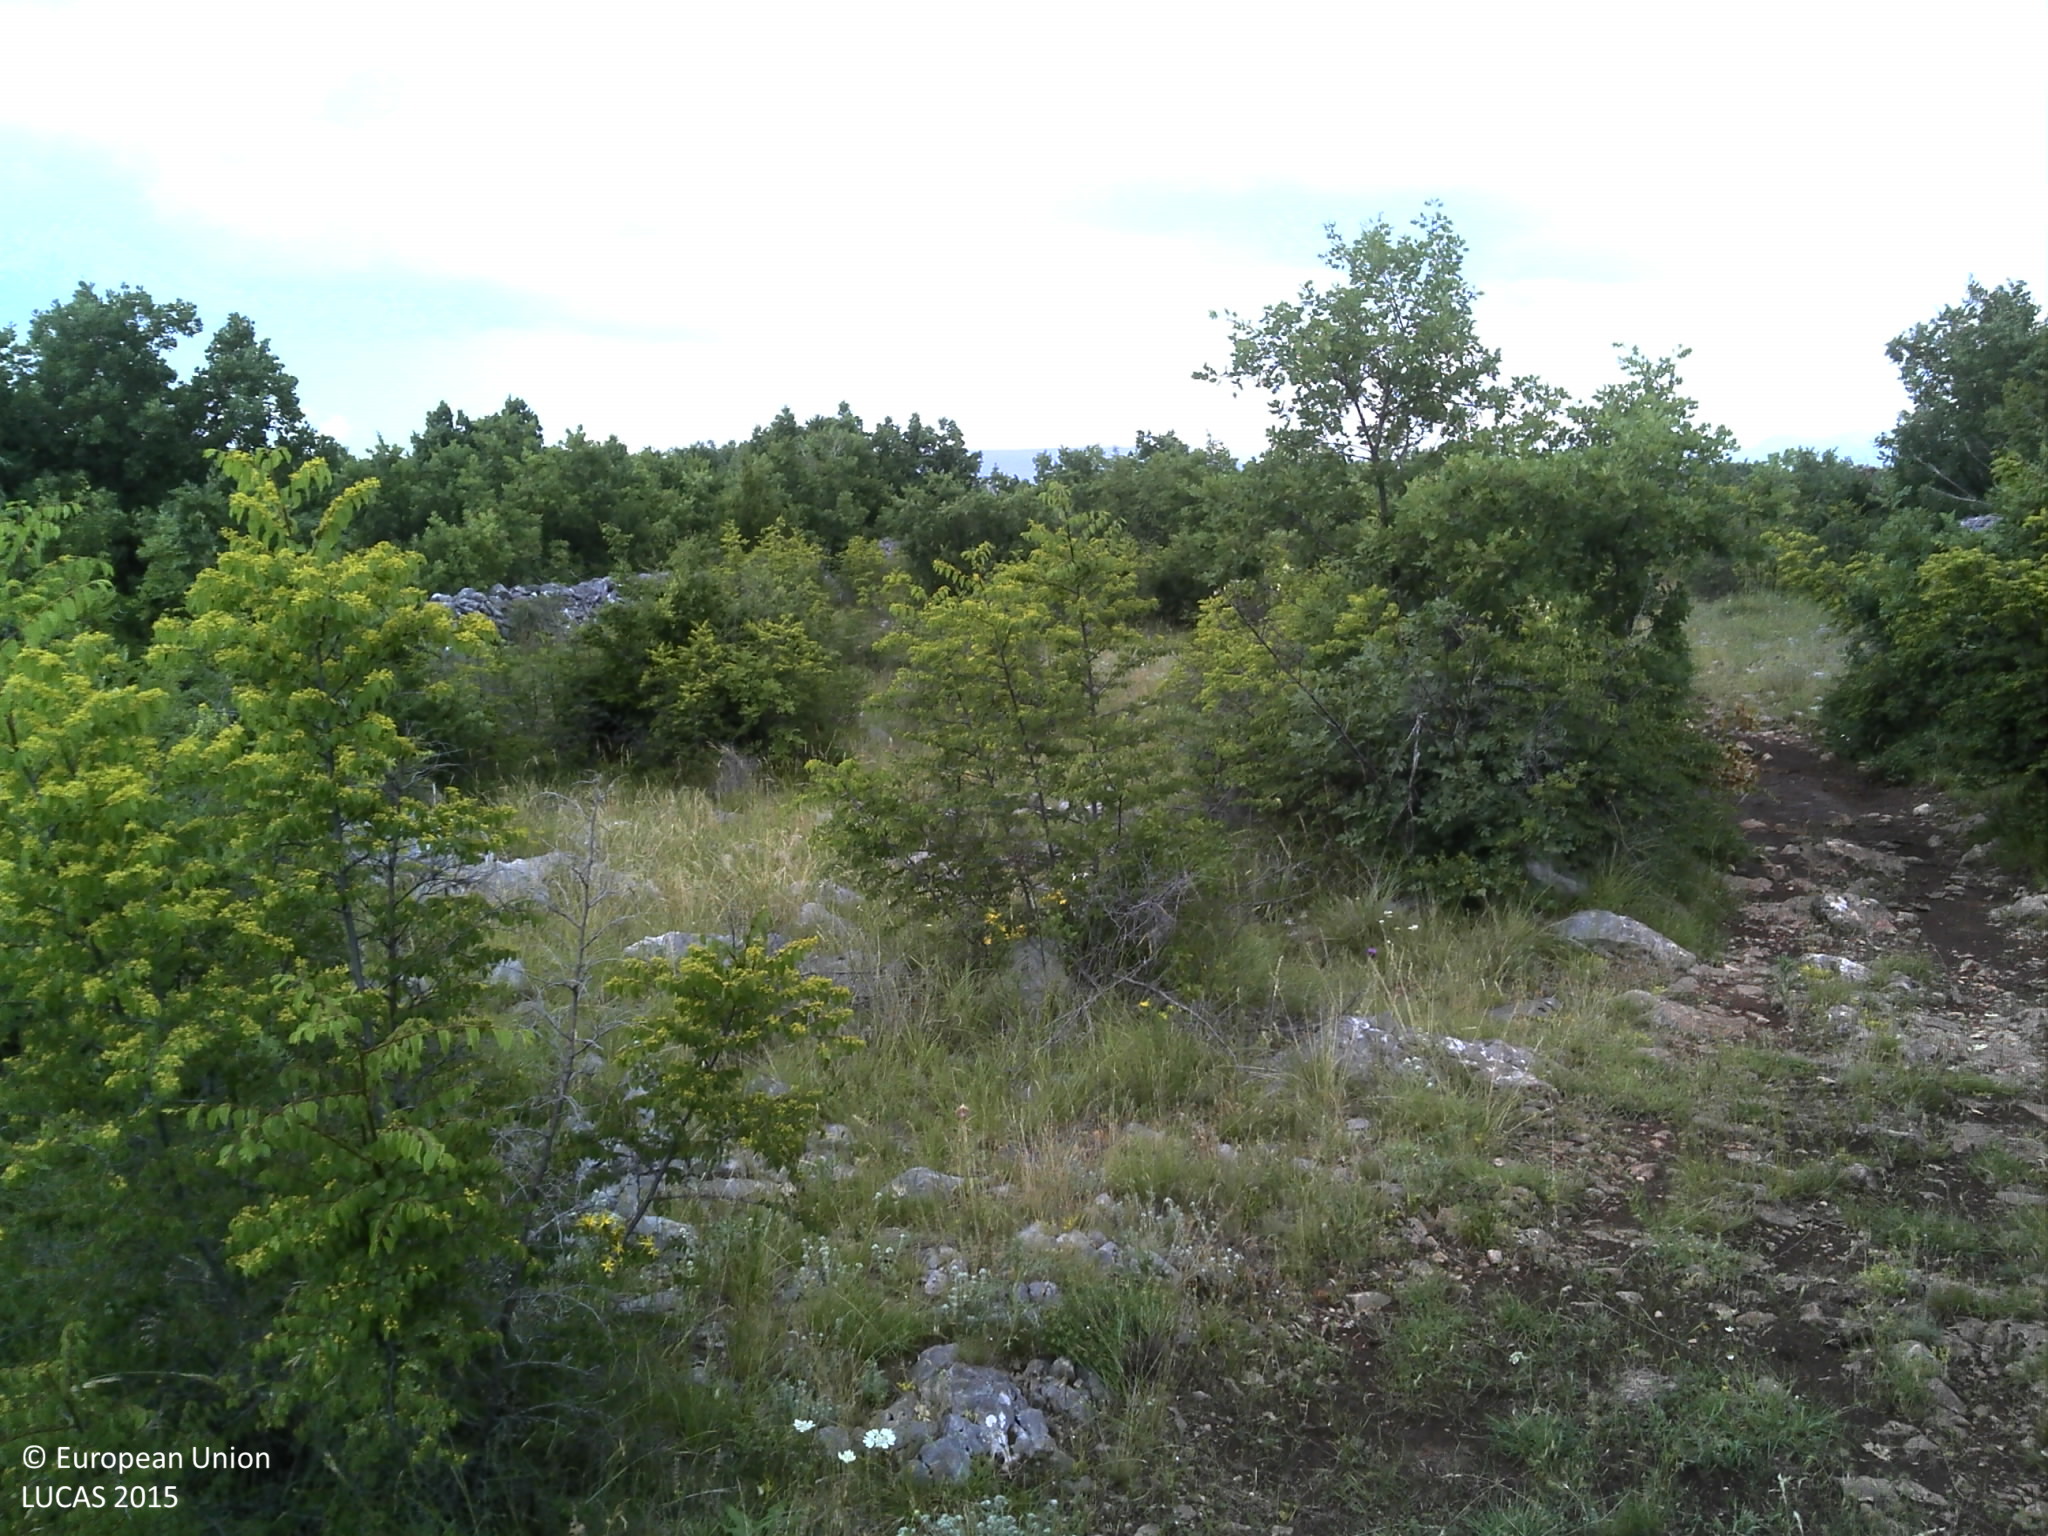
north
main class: Shrubland
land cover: Shrubland with sparse tree cover
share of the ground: 50 - 75 %
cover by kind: shrubs 45 %, herbaceous plants 45 %, broadleaved forest trees 5 %, unconsolidated bare surface 5 %
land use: Semi-natural and natural areas not in use
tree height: < 5 m
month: June
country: HR
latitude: 44.0059
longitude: 16.1411
